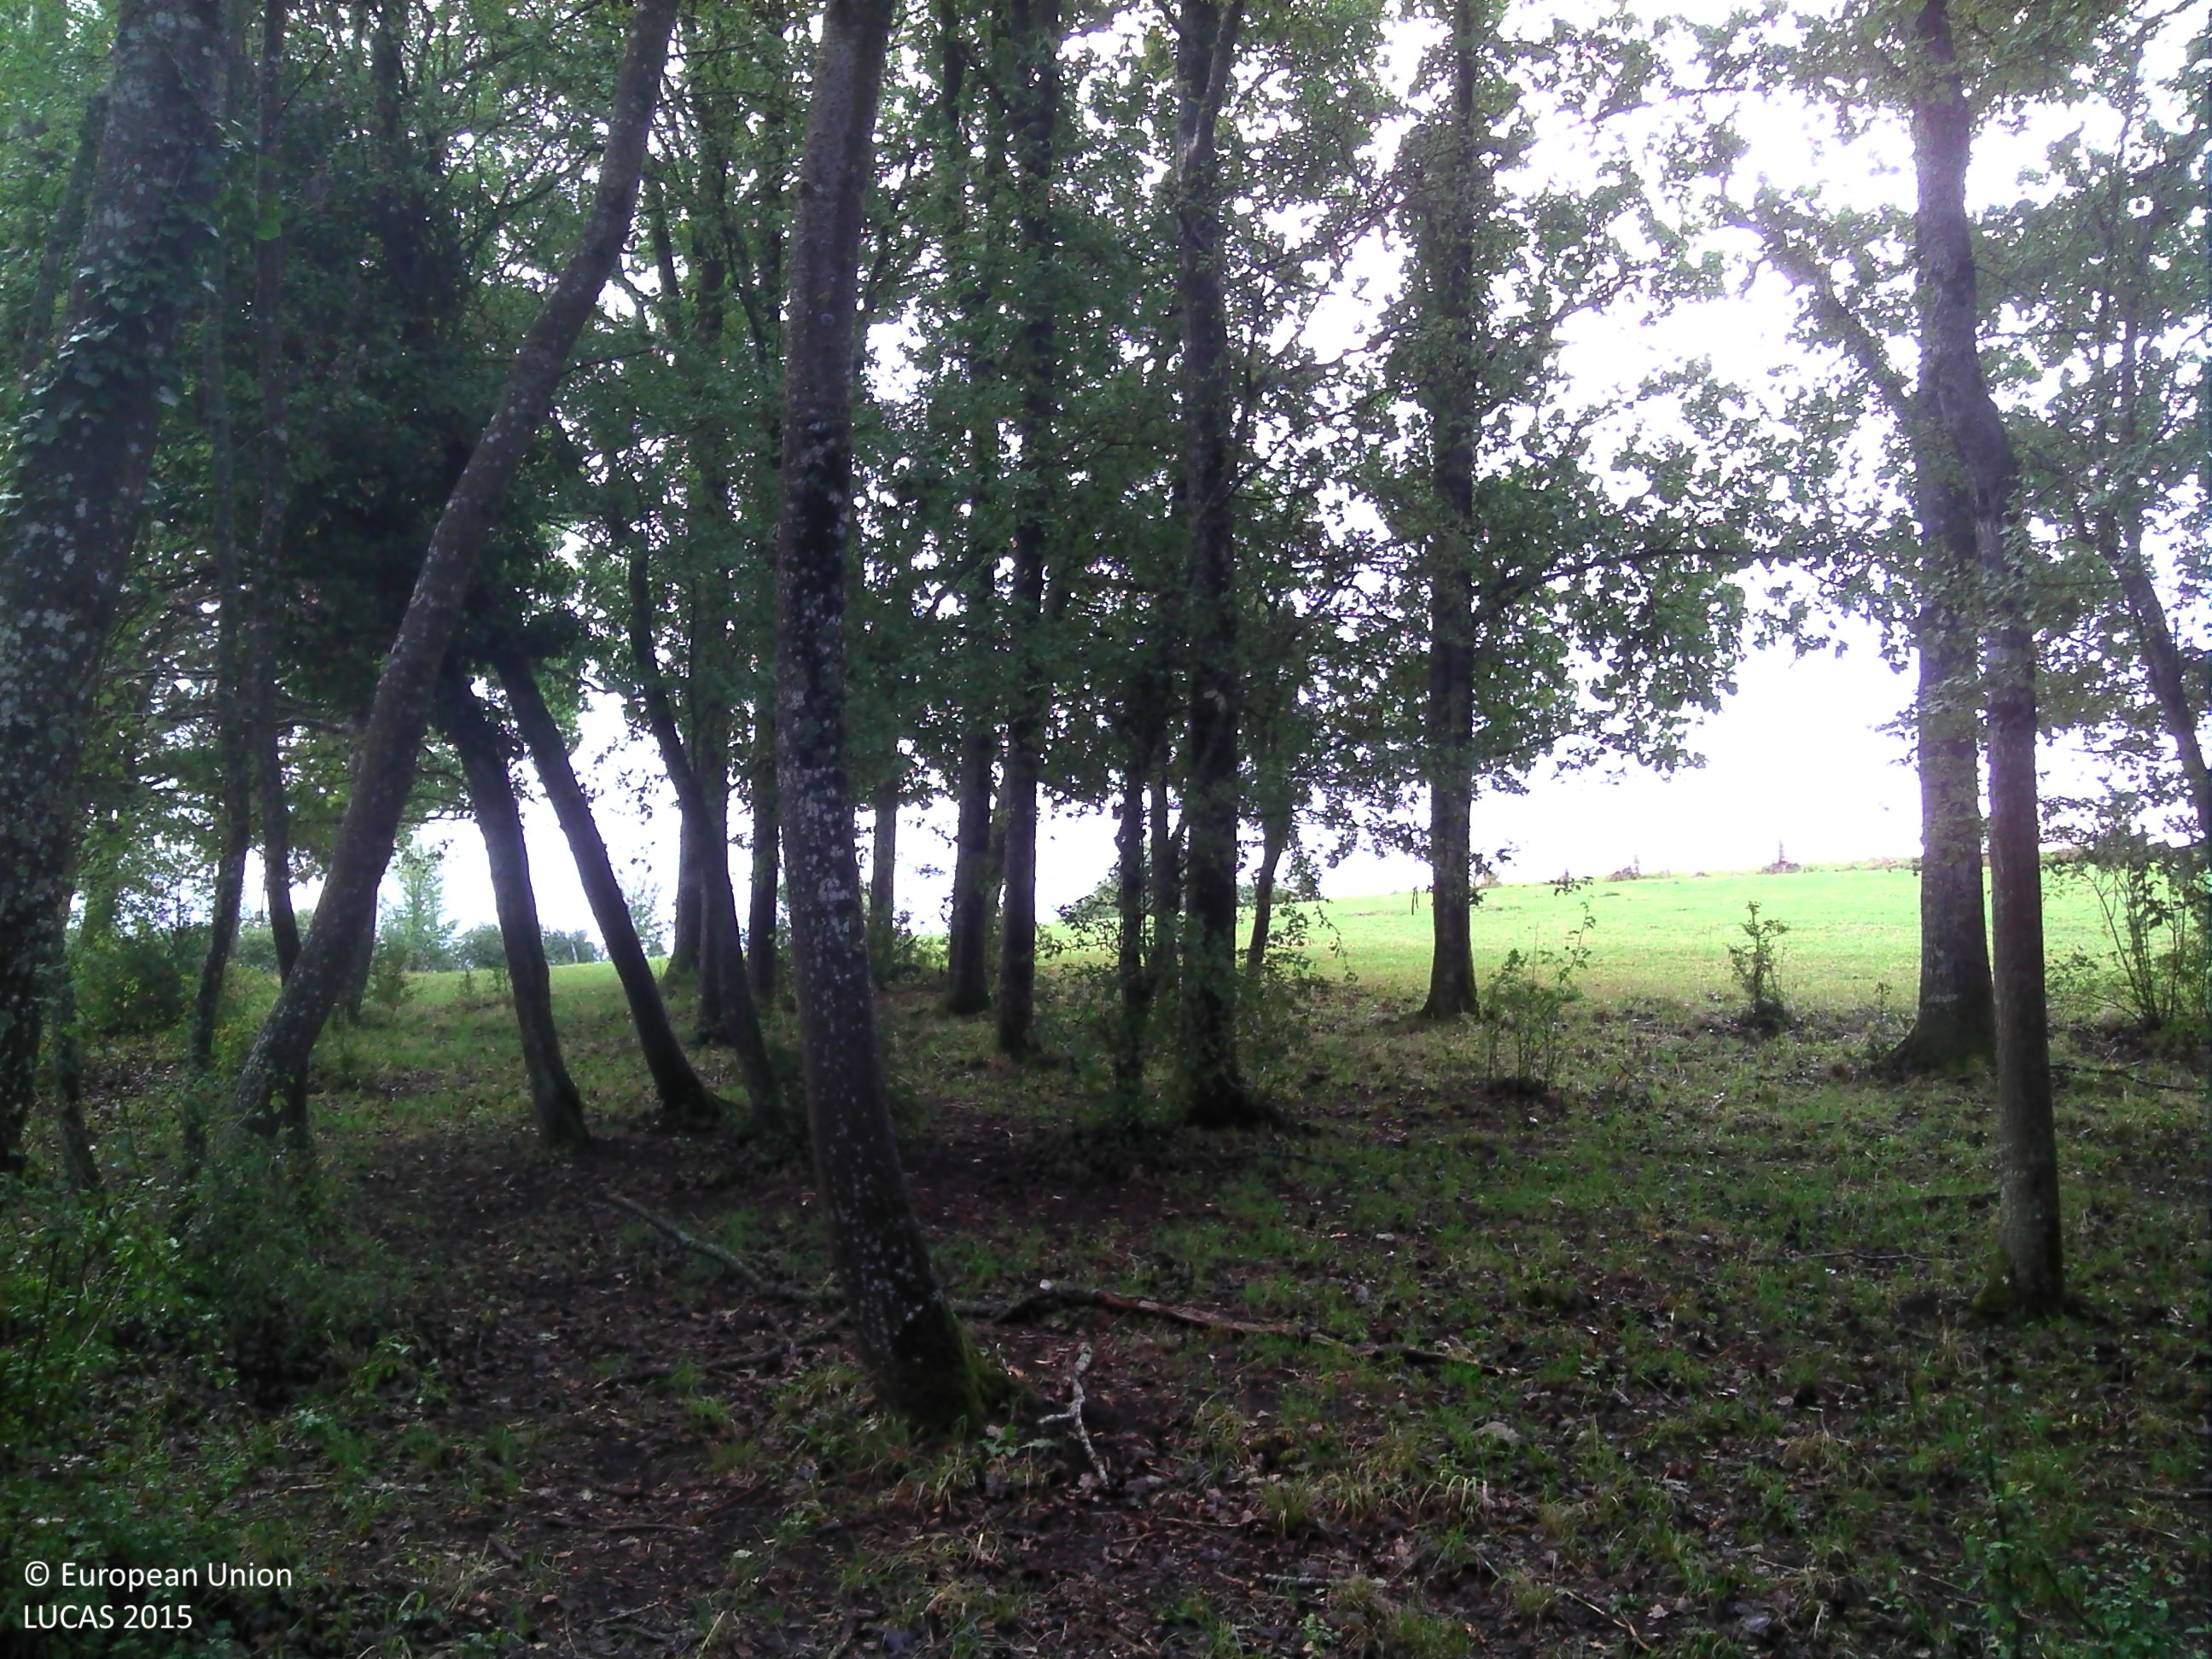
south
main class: Woodland
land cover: Broadleaved woodland
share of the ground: > 75 %
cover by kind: broadleaved forest trees 85 %, herbaceous plants 10 %, lichens and mosses 5 %
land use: Agriculture (excluding fallow land and kitchen gardens)
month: September
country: FR
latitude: 48.1099
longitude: 4.6123
